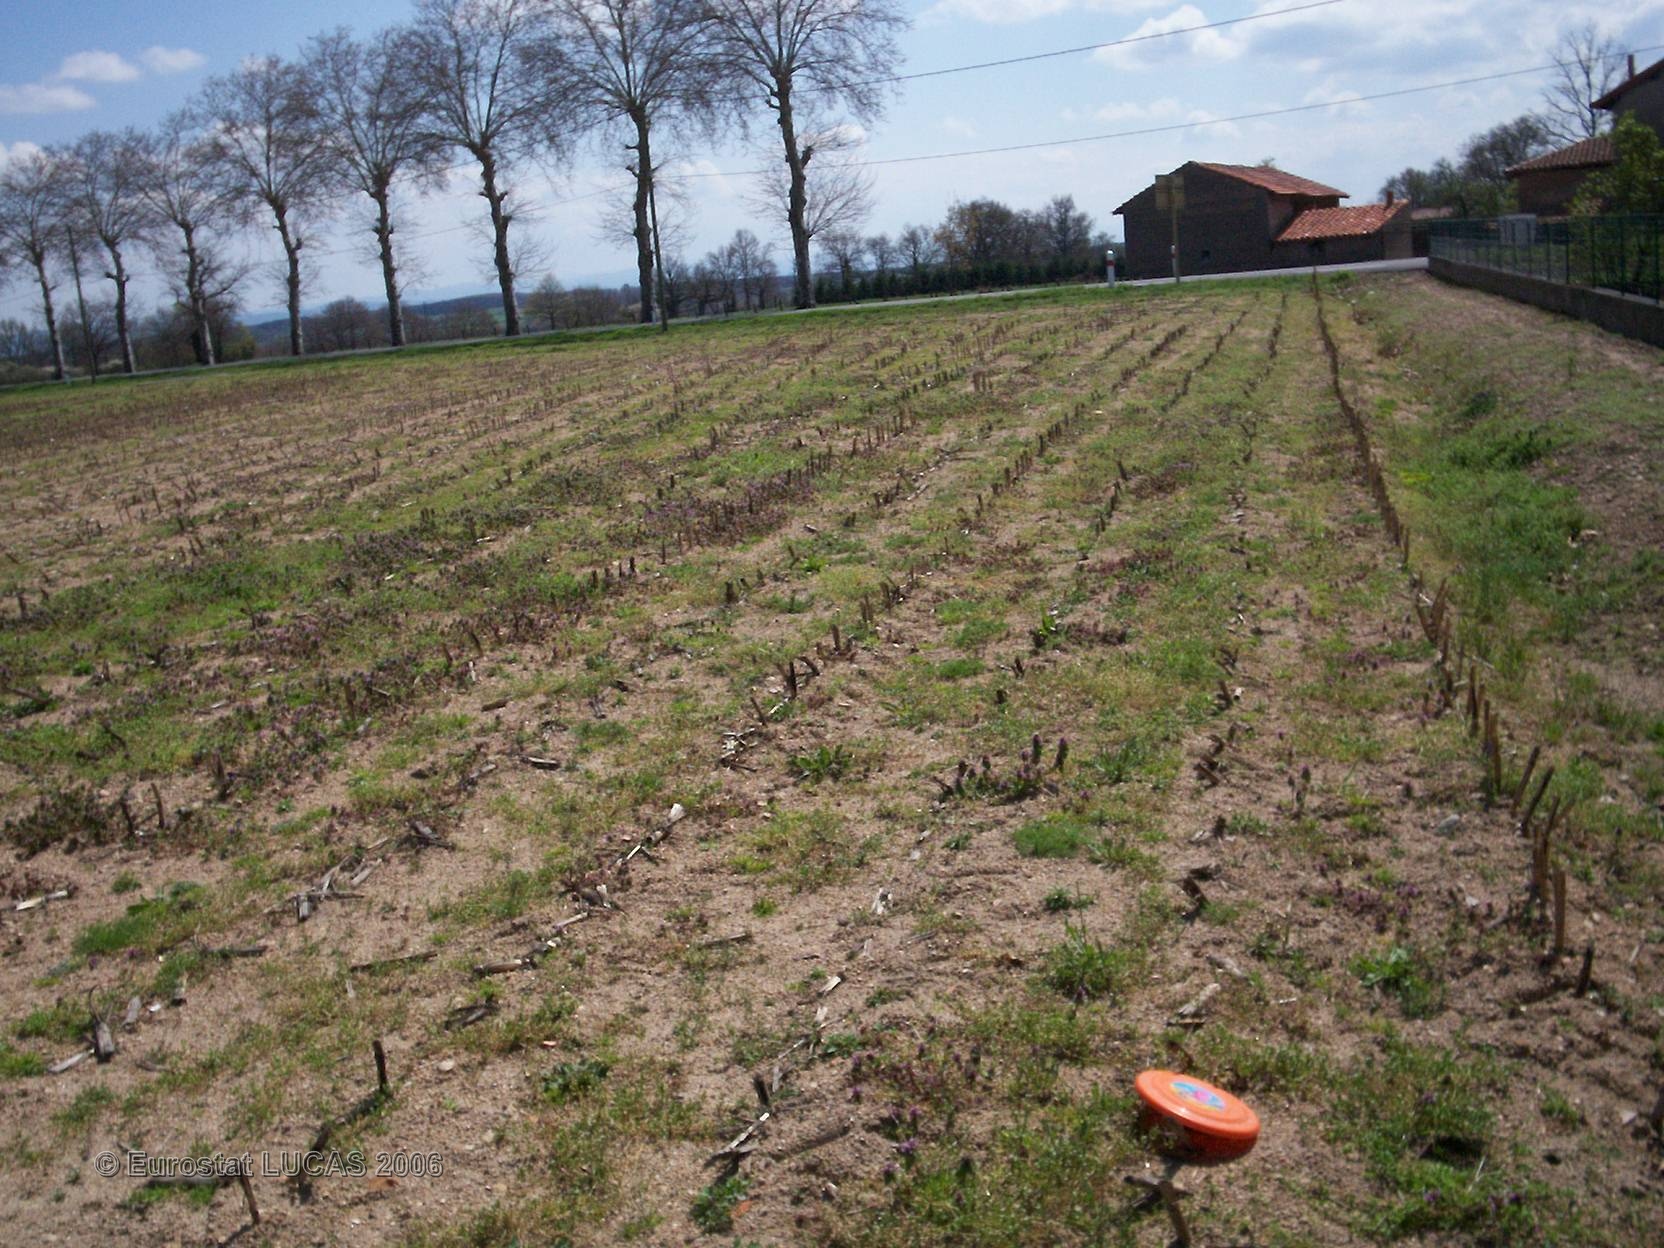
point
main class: Bare land
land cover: Bare land
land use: Fallow land
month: April
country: FR
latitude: 45.7385
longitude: 4.1292
